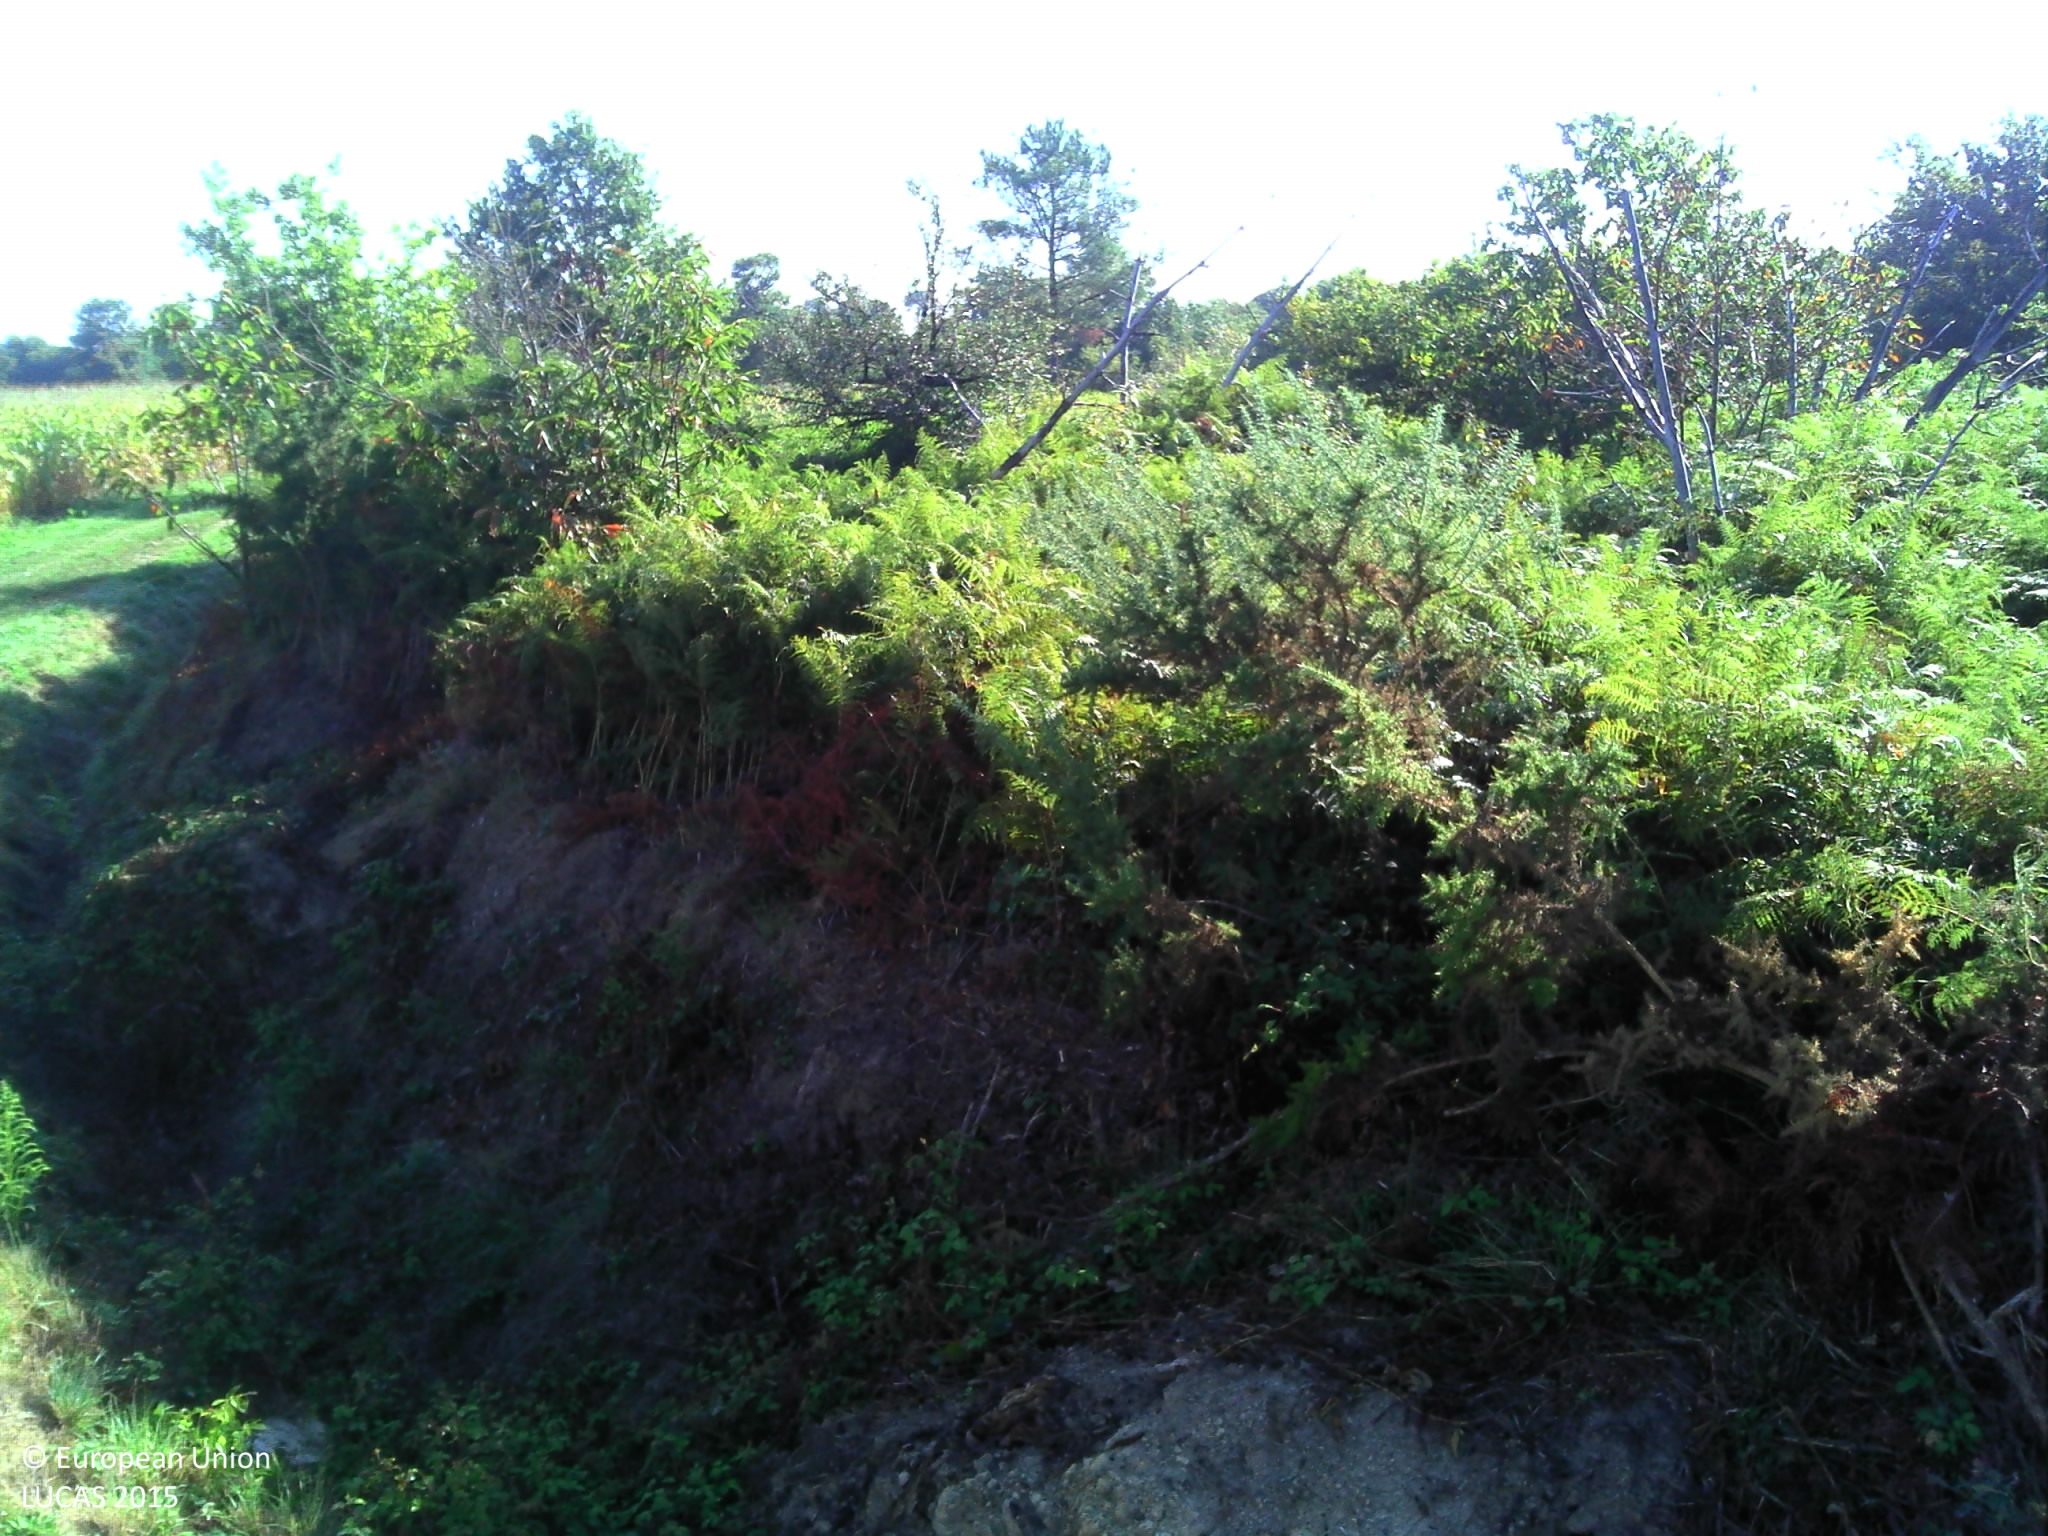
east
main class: Cropland
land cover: Maize
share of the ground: > 75 %
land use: Agriculture (excluding fallow land and kitchen gardens)
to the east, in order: Maize; Grass margins; Tracks; Ditches and canals; Spontaneously vegetated surfaces
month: September
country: FR
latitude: 43.5547
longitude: -0.7440
